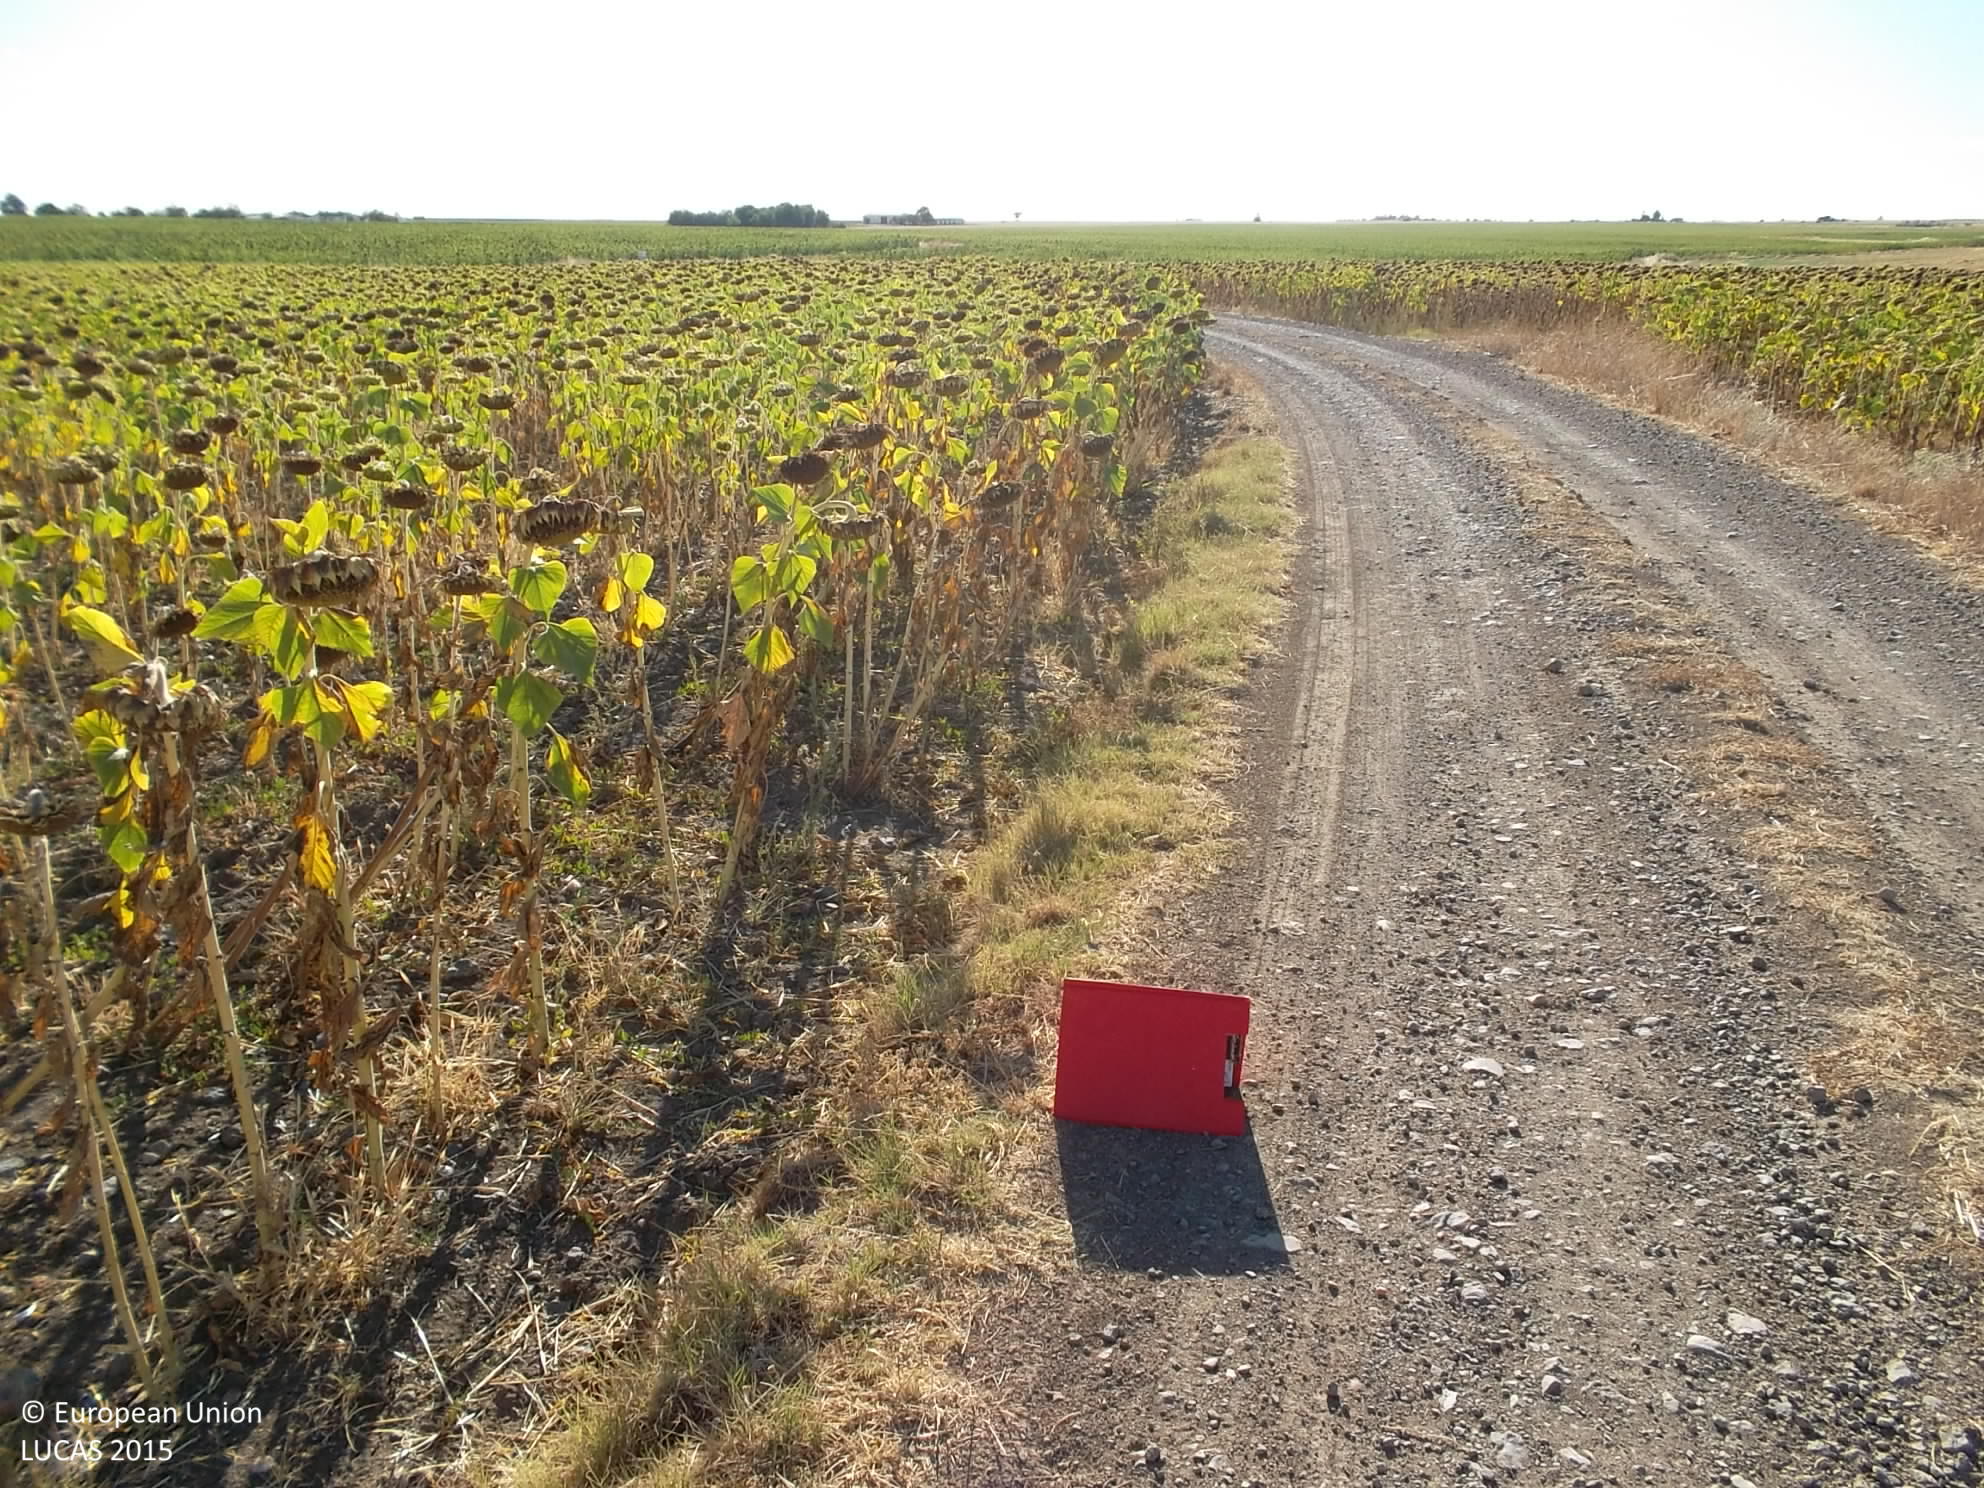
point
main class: Artificial land
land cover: Non built-up linear features
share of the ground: > 75 %
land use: Road transport
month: July
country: ES
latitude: 38.3111
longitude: -5.7152
